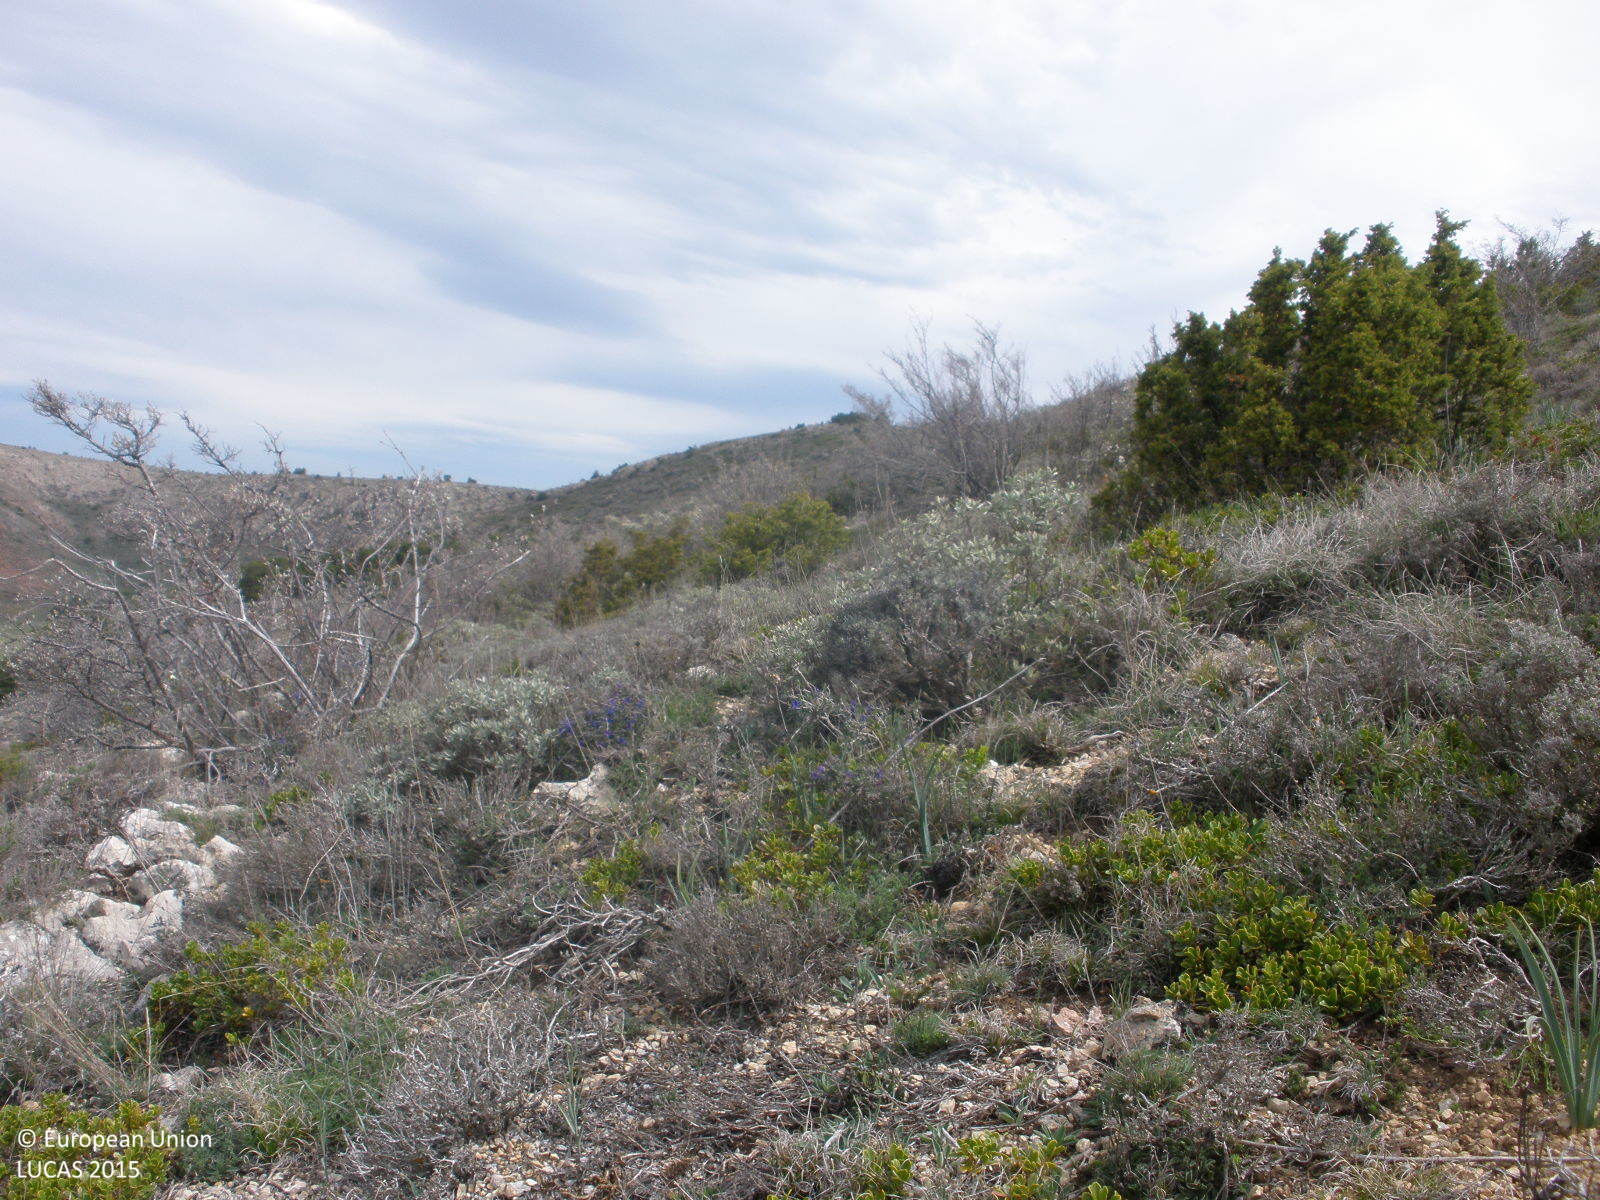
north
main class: Shrubland
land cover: Shrubland without tree cover
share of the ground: > 75 %
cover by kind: shrubs 75 %, herbaceous plants 15 %, consolidated bare surface 10 %
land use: Agriculture (excluding fallow land and kitchen gardens)
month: May
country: ES
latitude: 40.4562
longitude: -0.7758
